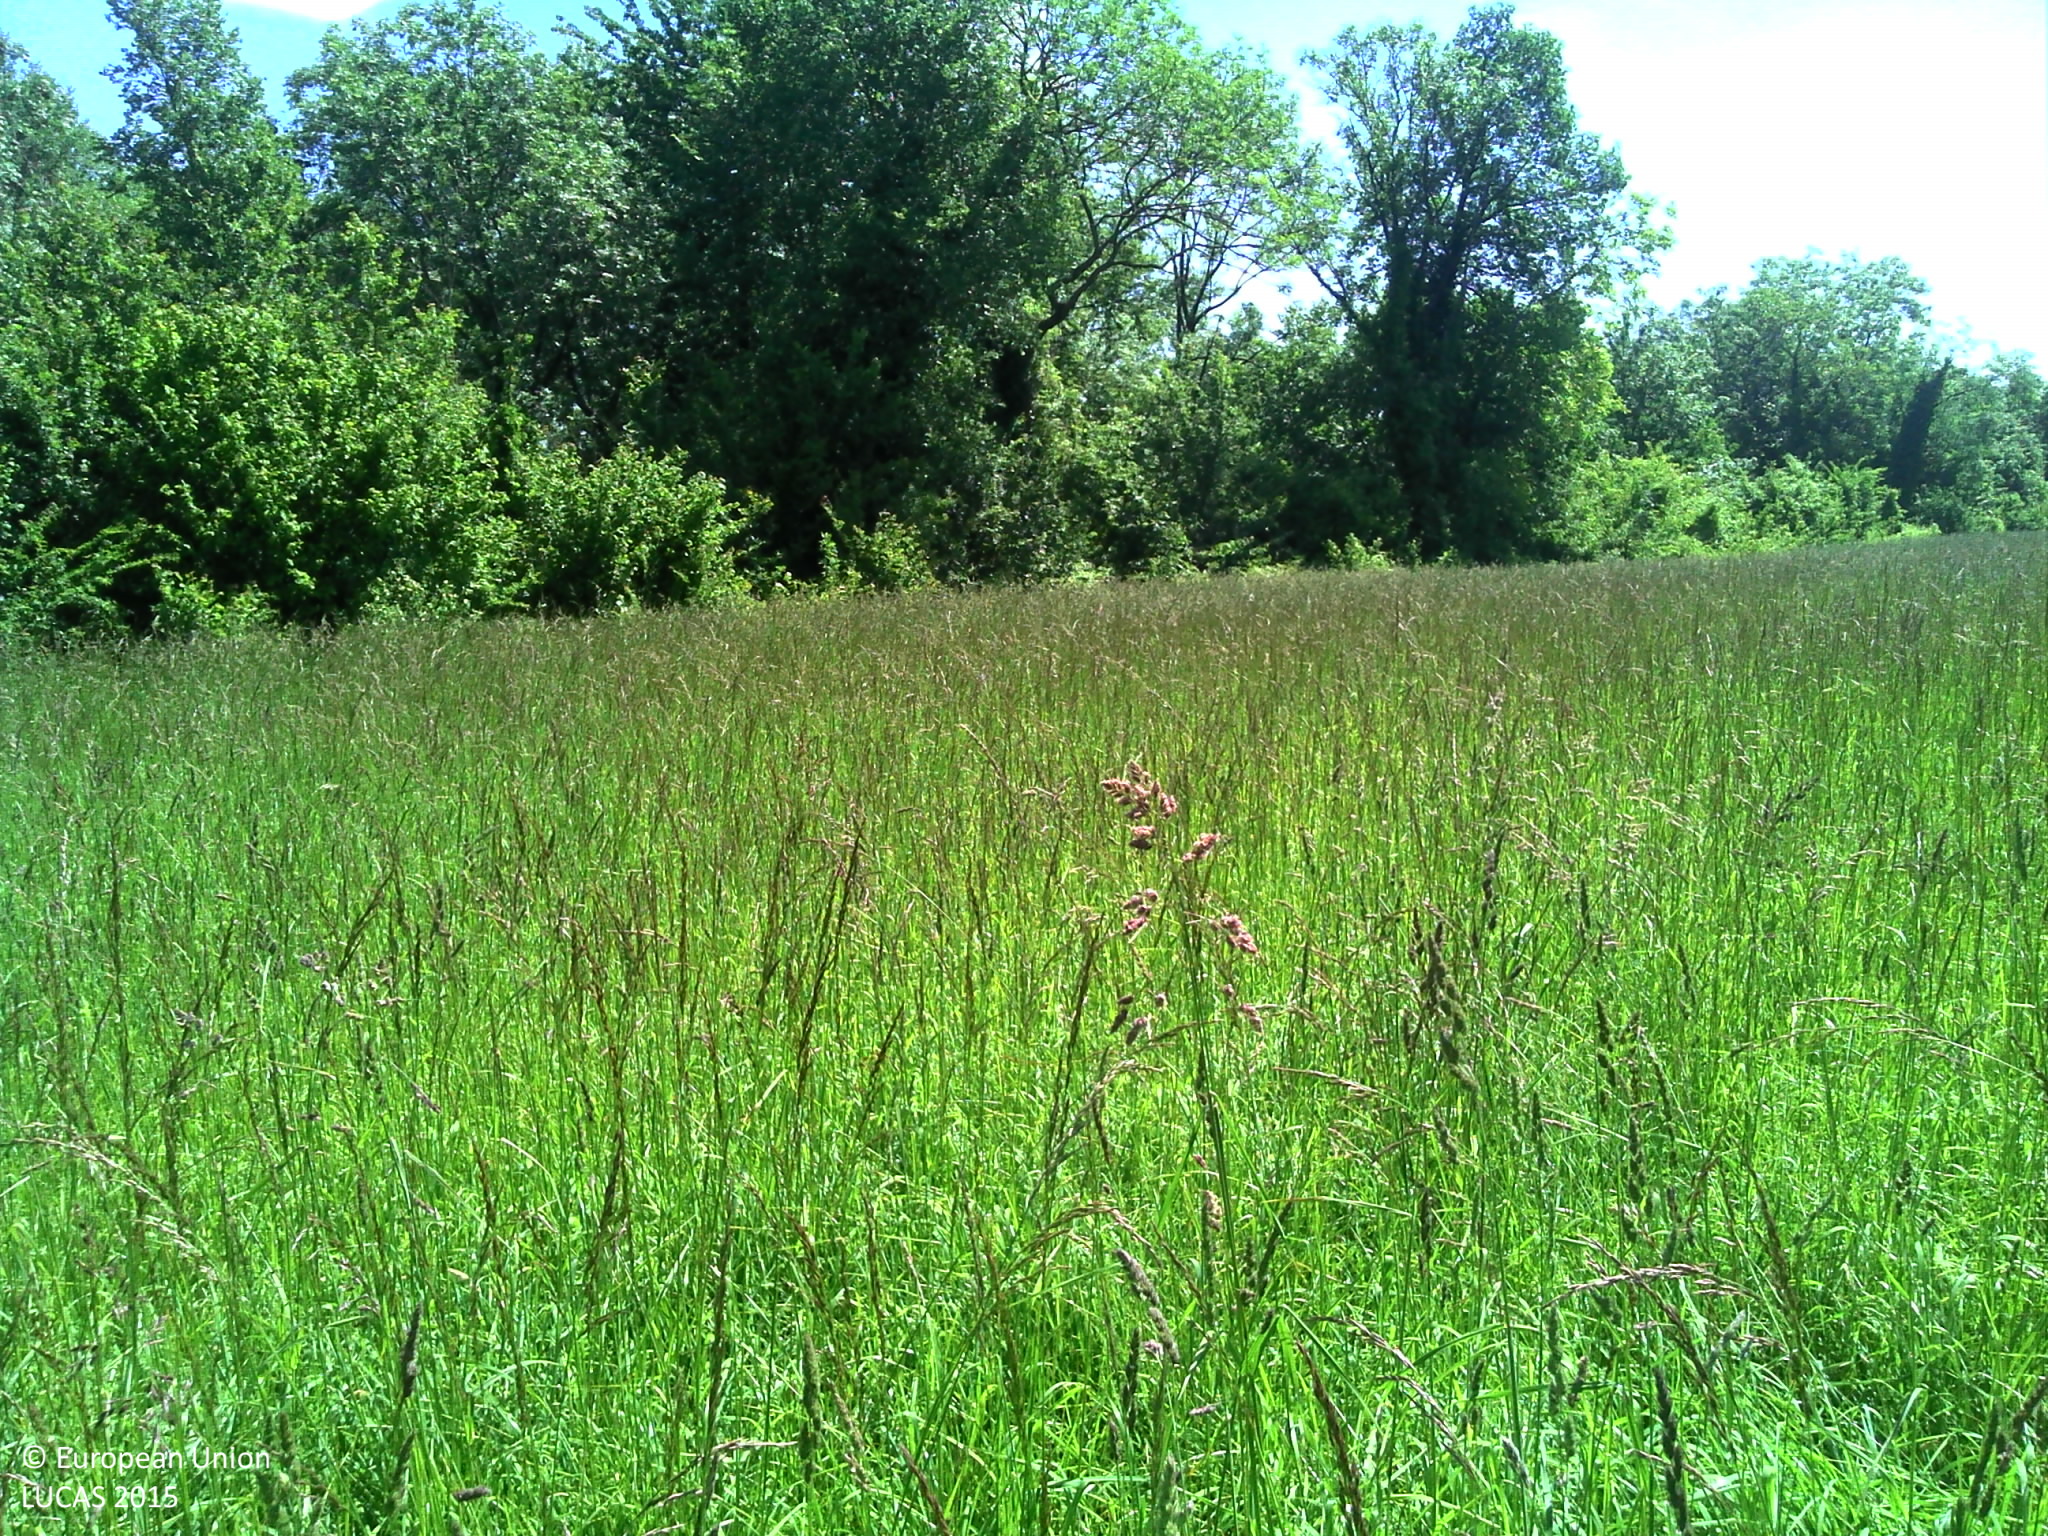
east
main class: Cropland
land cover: Temporary grasslands
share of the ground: > 75 %
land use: Agriculture (excluding fallow land and kitchen gardens)
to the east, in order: Temporary grasslands; Broadleaved woodland; Grassland without tree/shrub cover
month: June
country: FR
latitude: 49.4280
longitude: 3.3050
